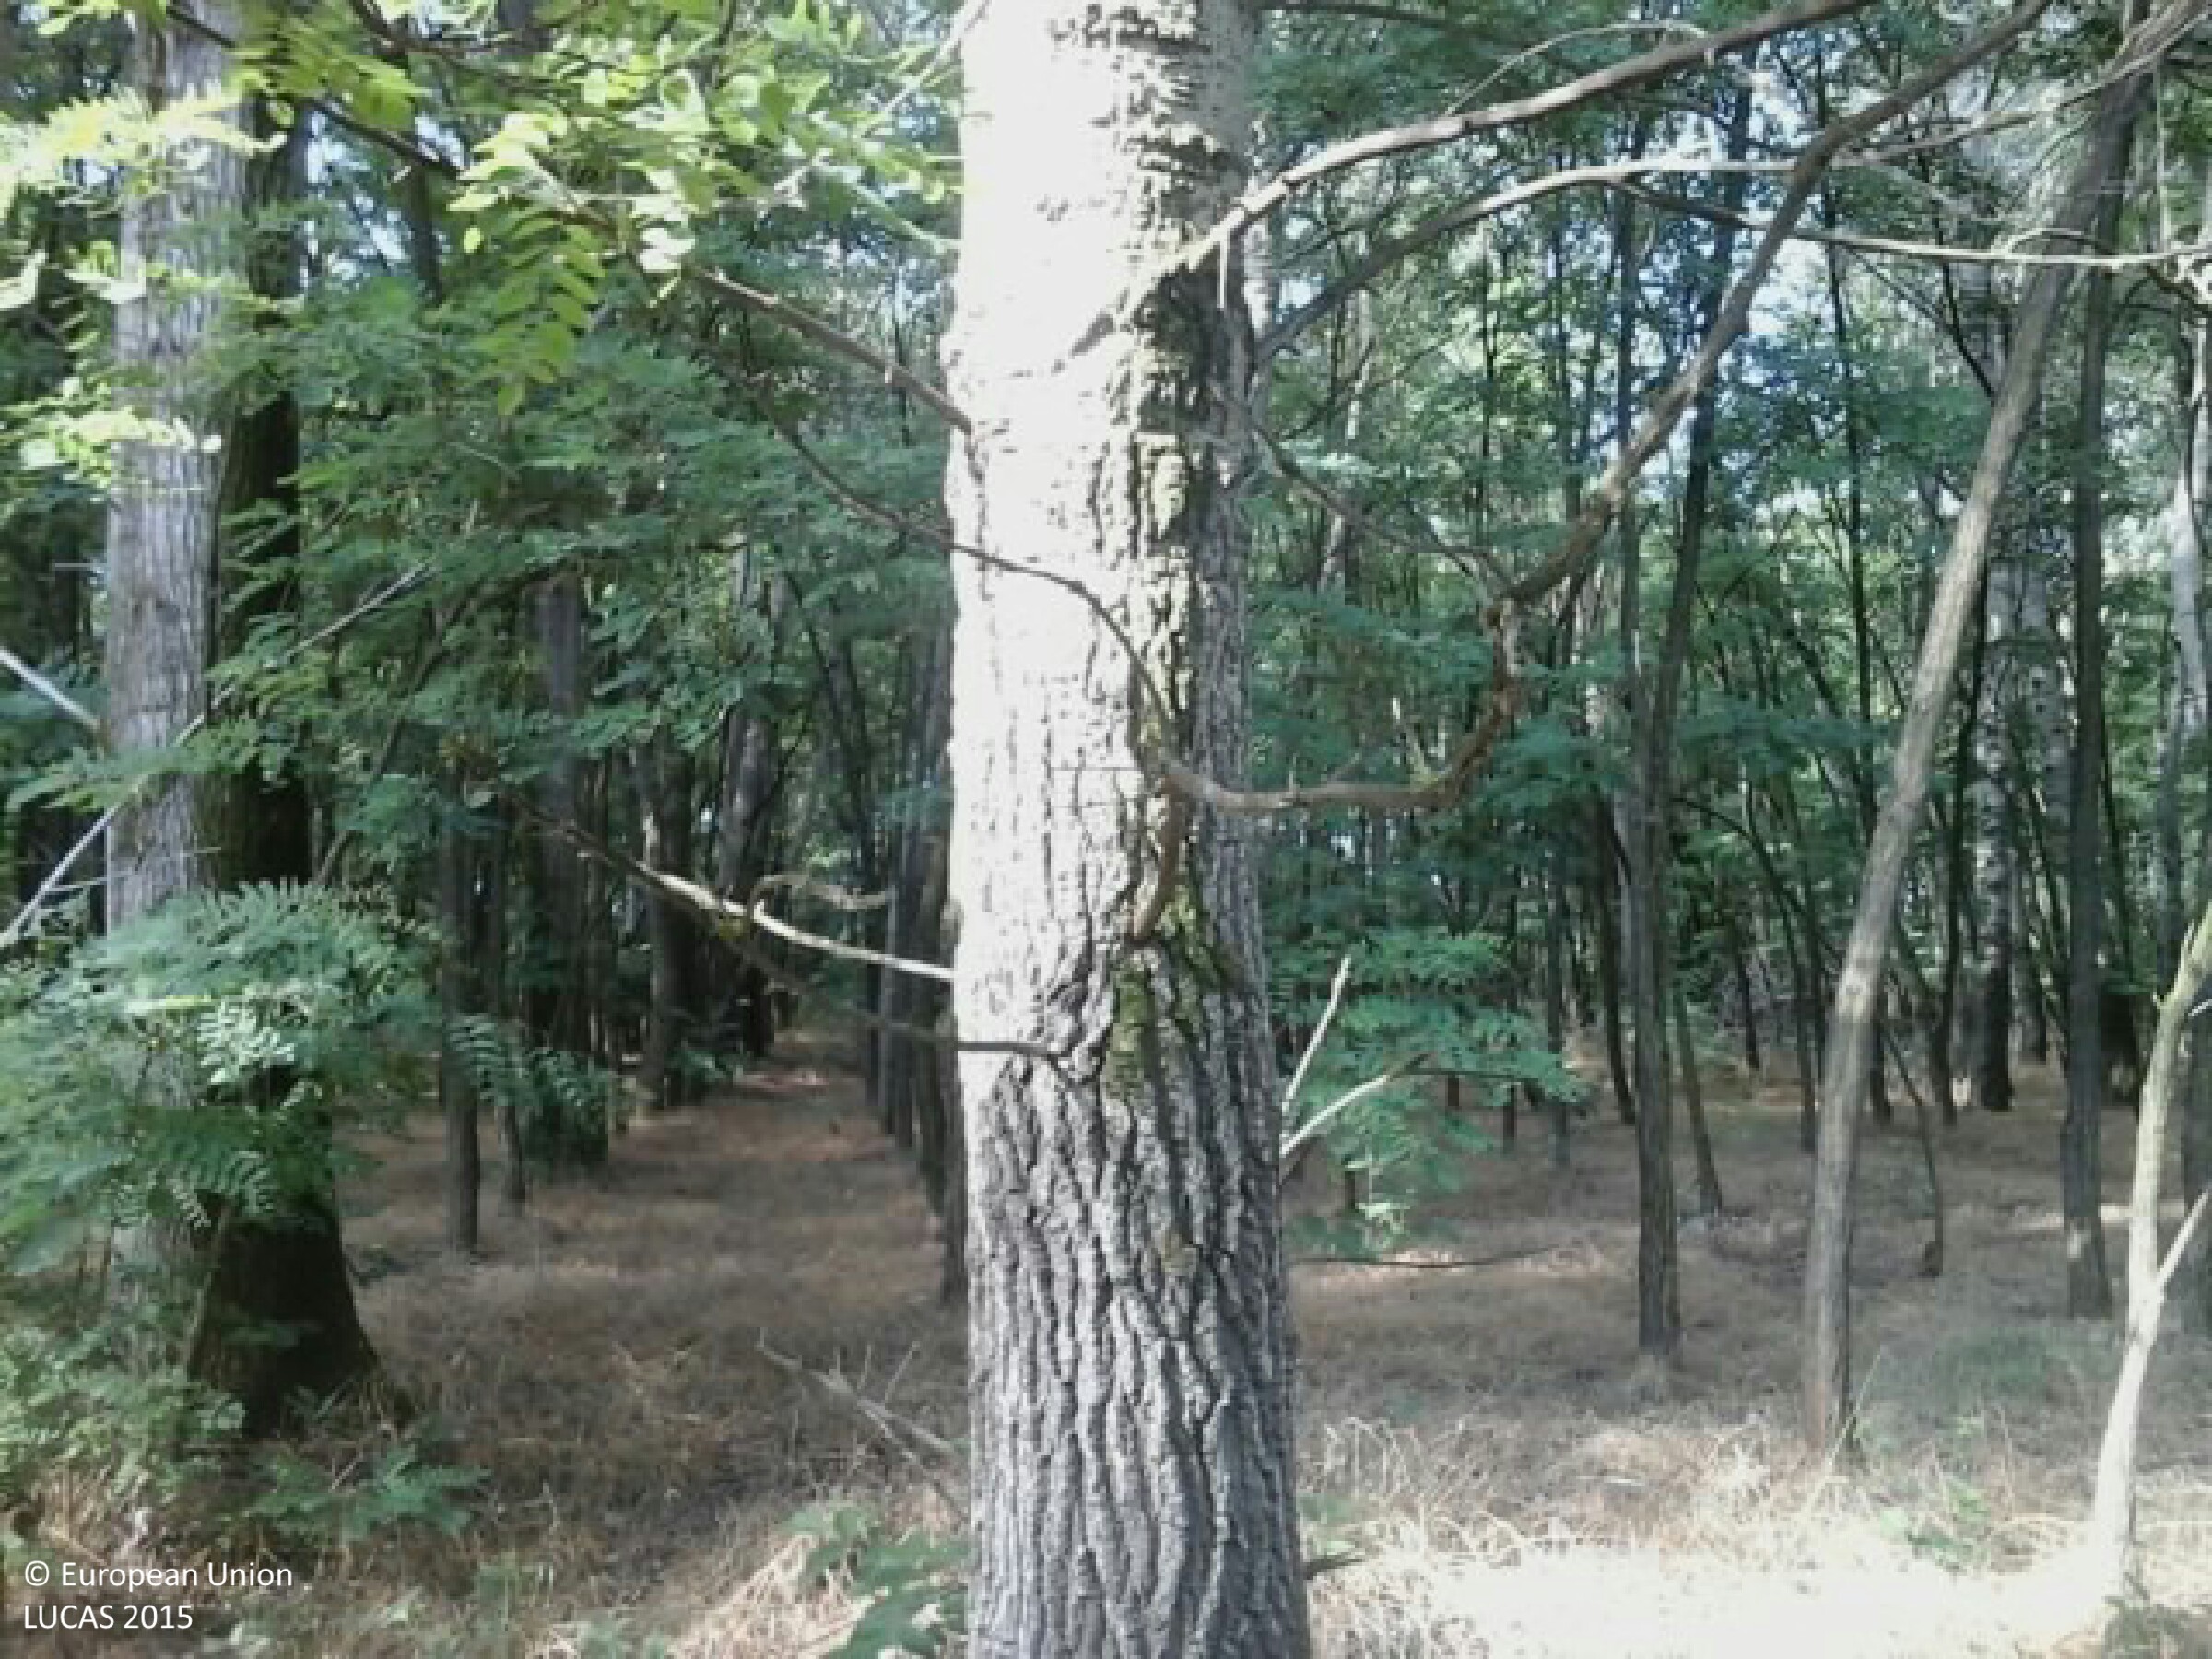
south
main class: Woodland
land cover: Broadleaved woodland
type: exotic forest
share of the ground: 50 - 75 %
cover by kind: broadleaved forest trees 90 %, herbaceous plants 10 %
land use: Forestry
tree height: > 5 m
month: June
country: HU
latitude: 46.8404
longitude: 19.6312
